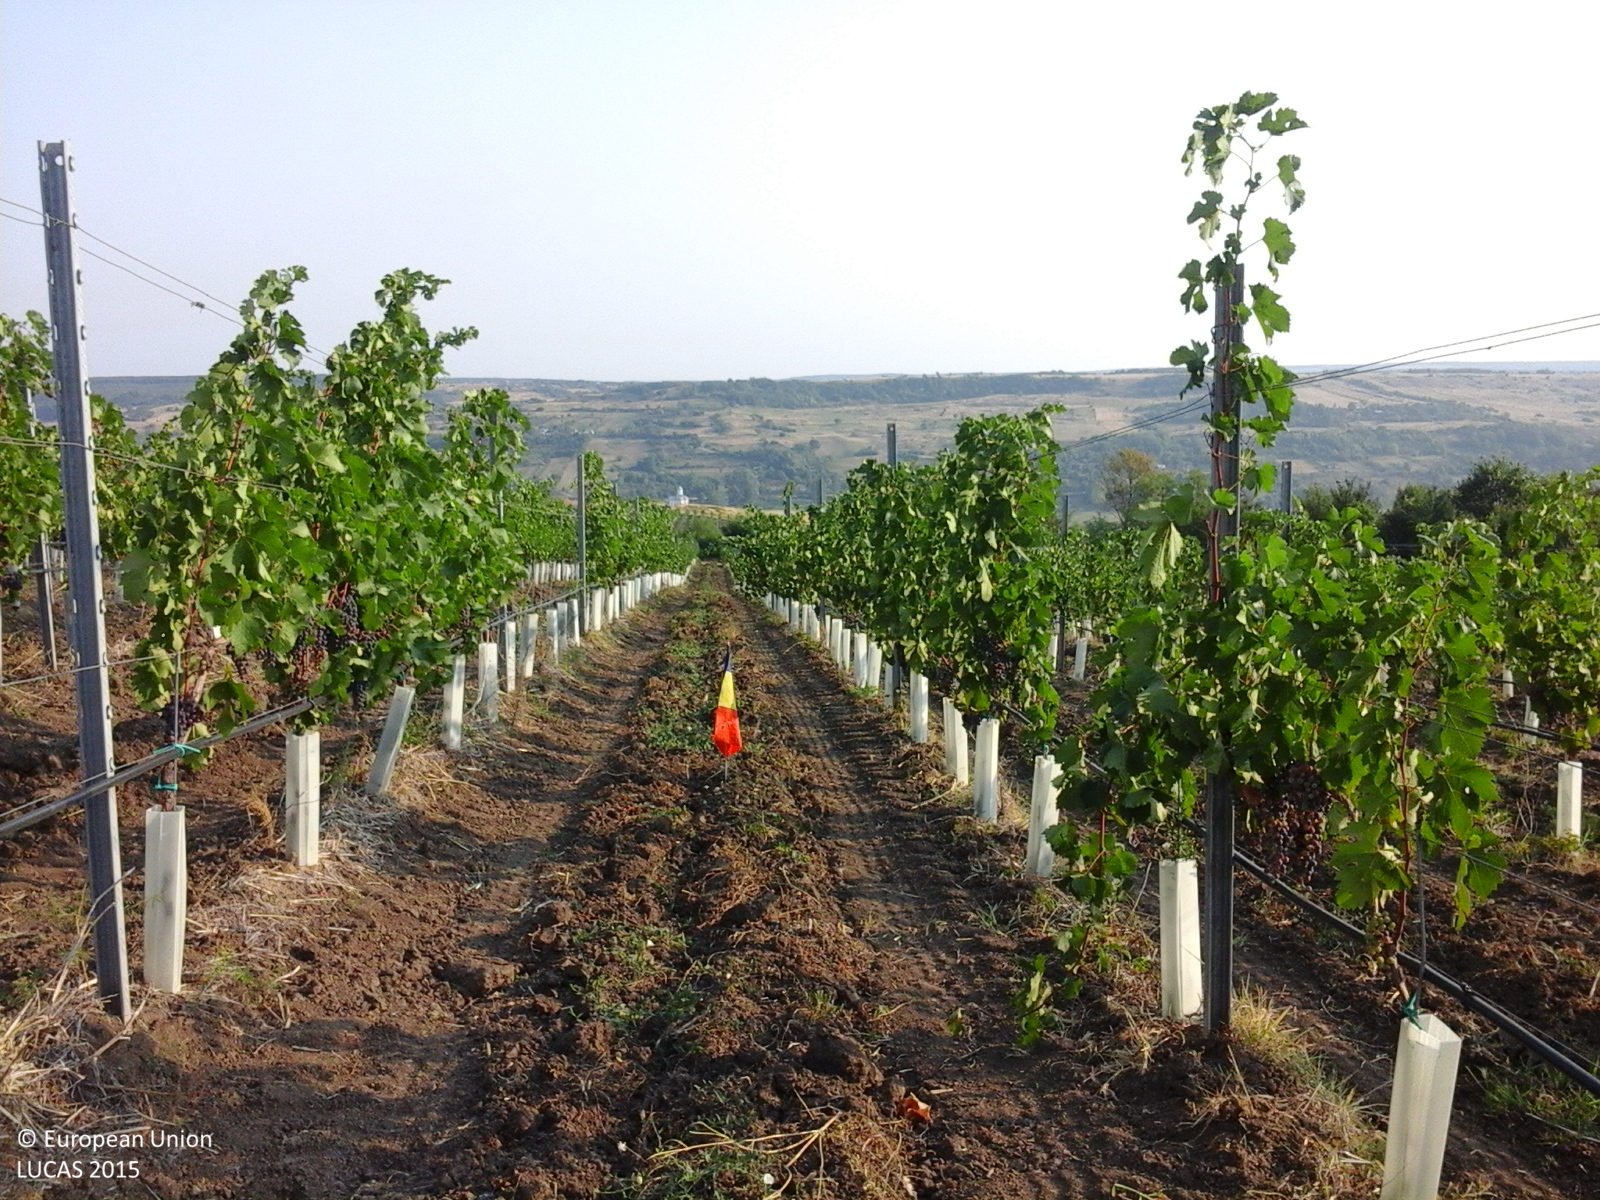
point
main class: Cropland
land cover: Vineyards
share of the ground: 25 - 50 %
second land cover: Other bare soil
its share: > 75 %
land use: Agriculture (excluding fallow land and kitchen gardens)
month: August
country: RO
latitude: 44.4921
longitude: 23.3172
